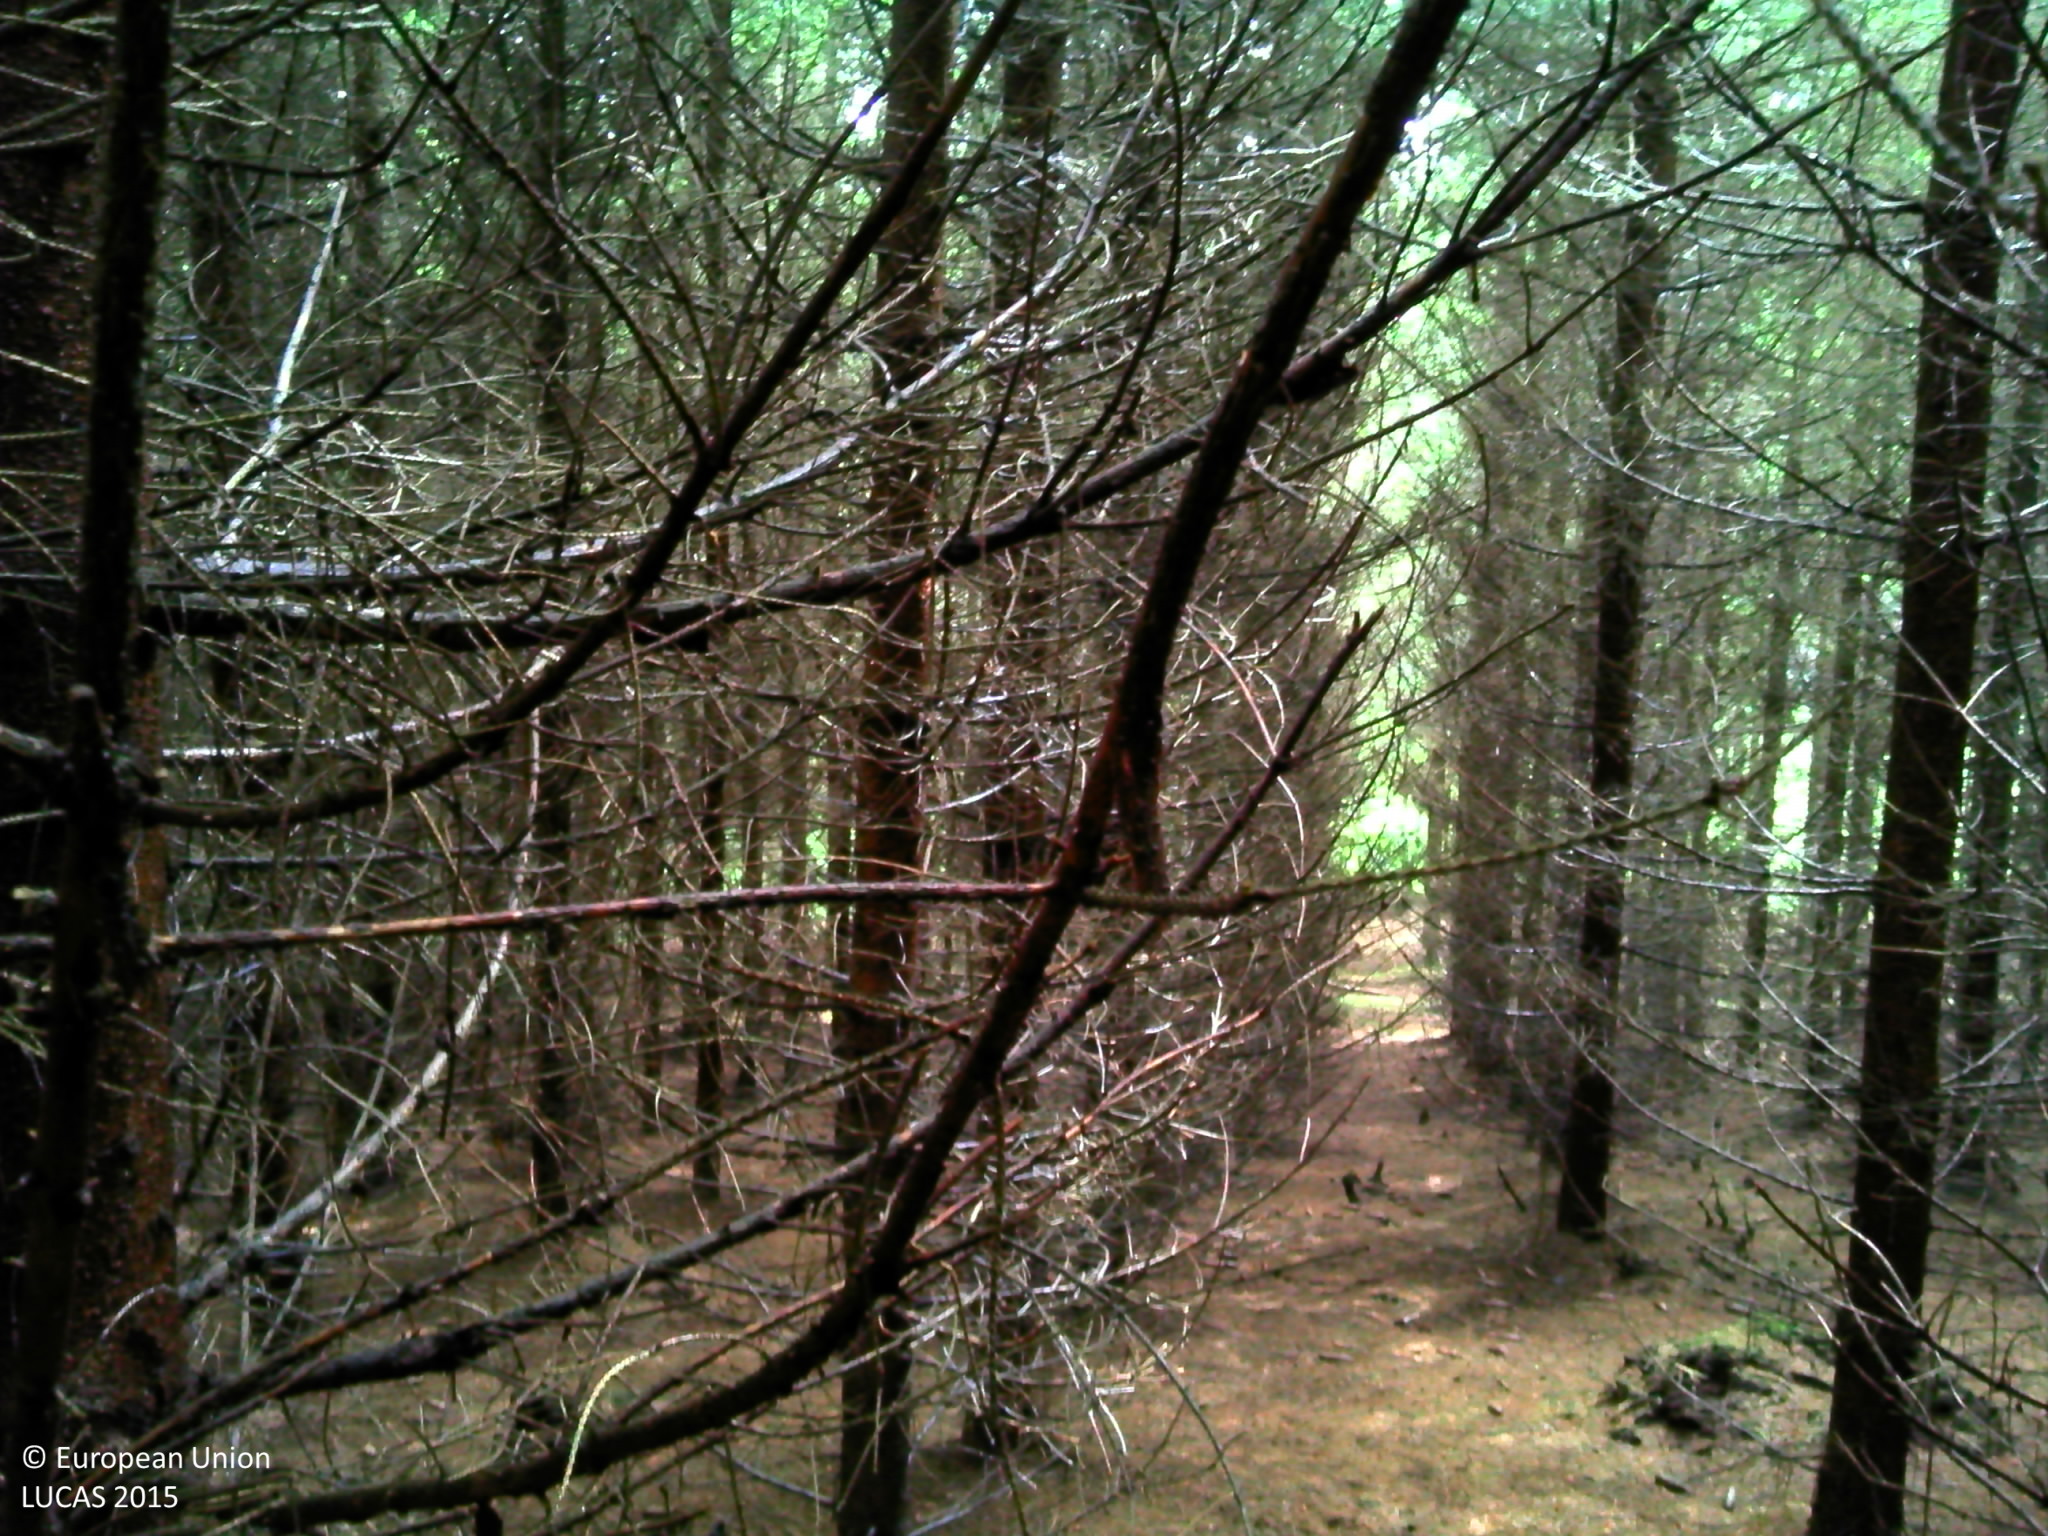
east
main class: Woodland
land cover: Spruce dominated coniferous woodland
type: alpine coniferous forest
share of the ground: > 75 %
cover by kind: coniferous forest trees 100 %
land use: Forestry
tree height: > 5 m
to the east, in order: Spruce dominated coniferous woodland; Tracks; Spruce dominated coniferous woodland; Broadleaved woodland; Spruce dominated coniferous woodland; Abandoned hedges; Spruce dominated coniferous woodland
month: June
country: BE
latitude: 50.2987
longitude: 5.6325
